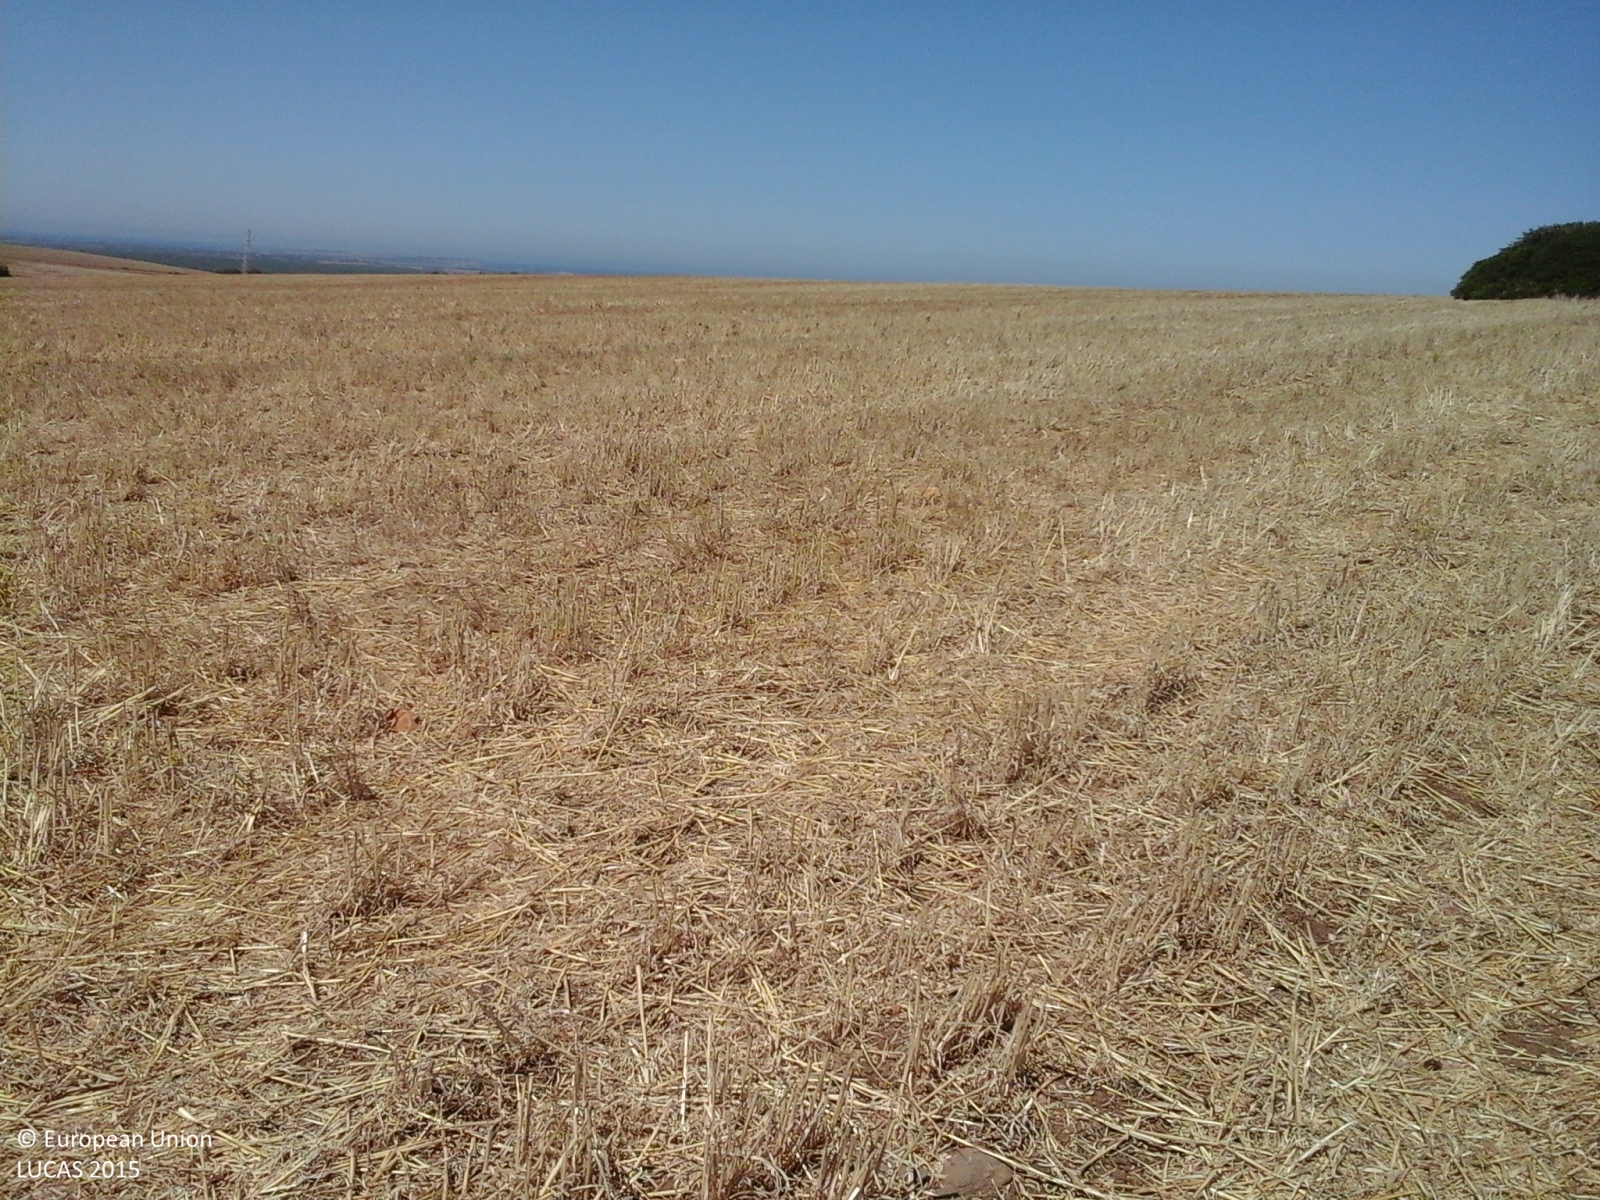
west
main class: Cropland
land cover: Durum wheat
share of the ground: > 75 %
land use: Agriculture (excluding fallow land and kitchen gardens)
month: August
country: IT
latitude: 40.0570
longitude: 8.5192
